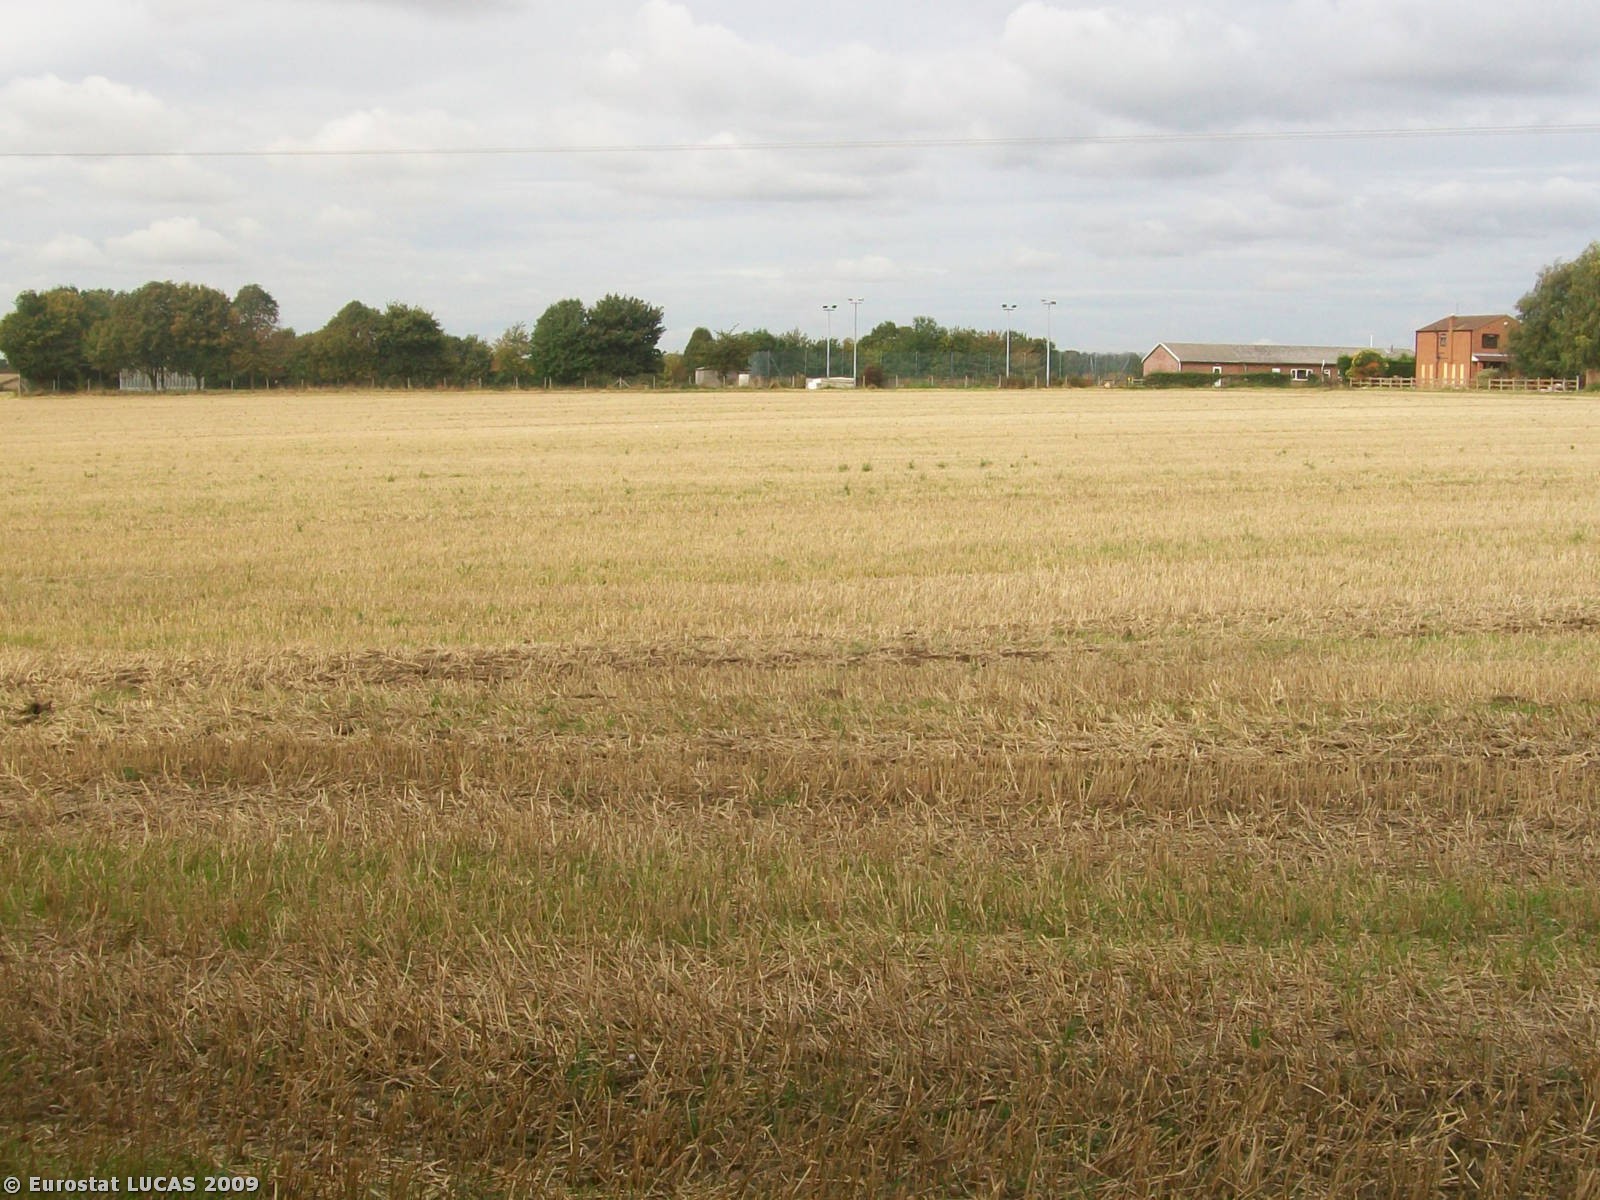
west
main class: Bare land
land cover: Bare land
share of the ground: < 10 %
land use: Agriculture (excluding fallow land and kitchen gardens)
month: September
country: GB
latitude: 52.4827
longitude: -1.3727
